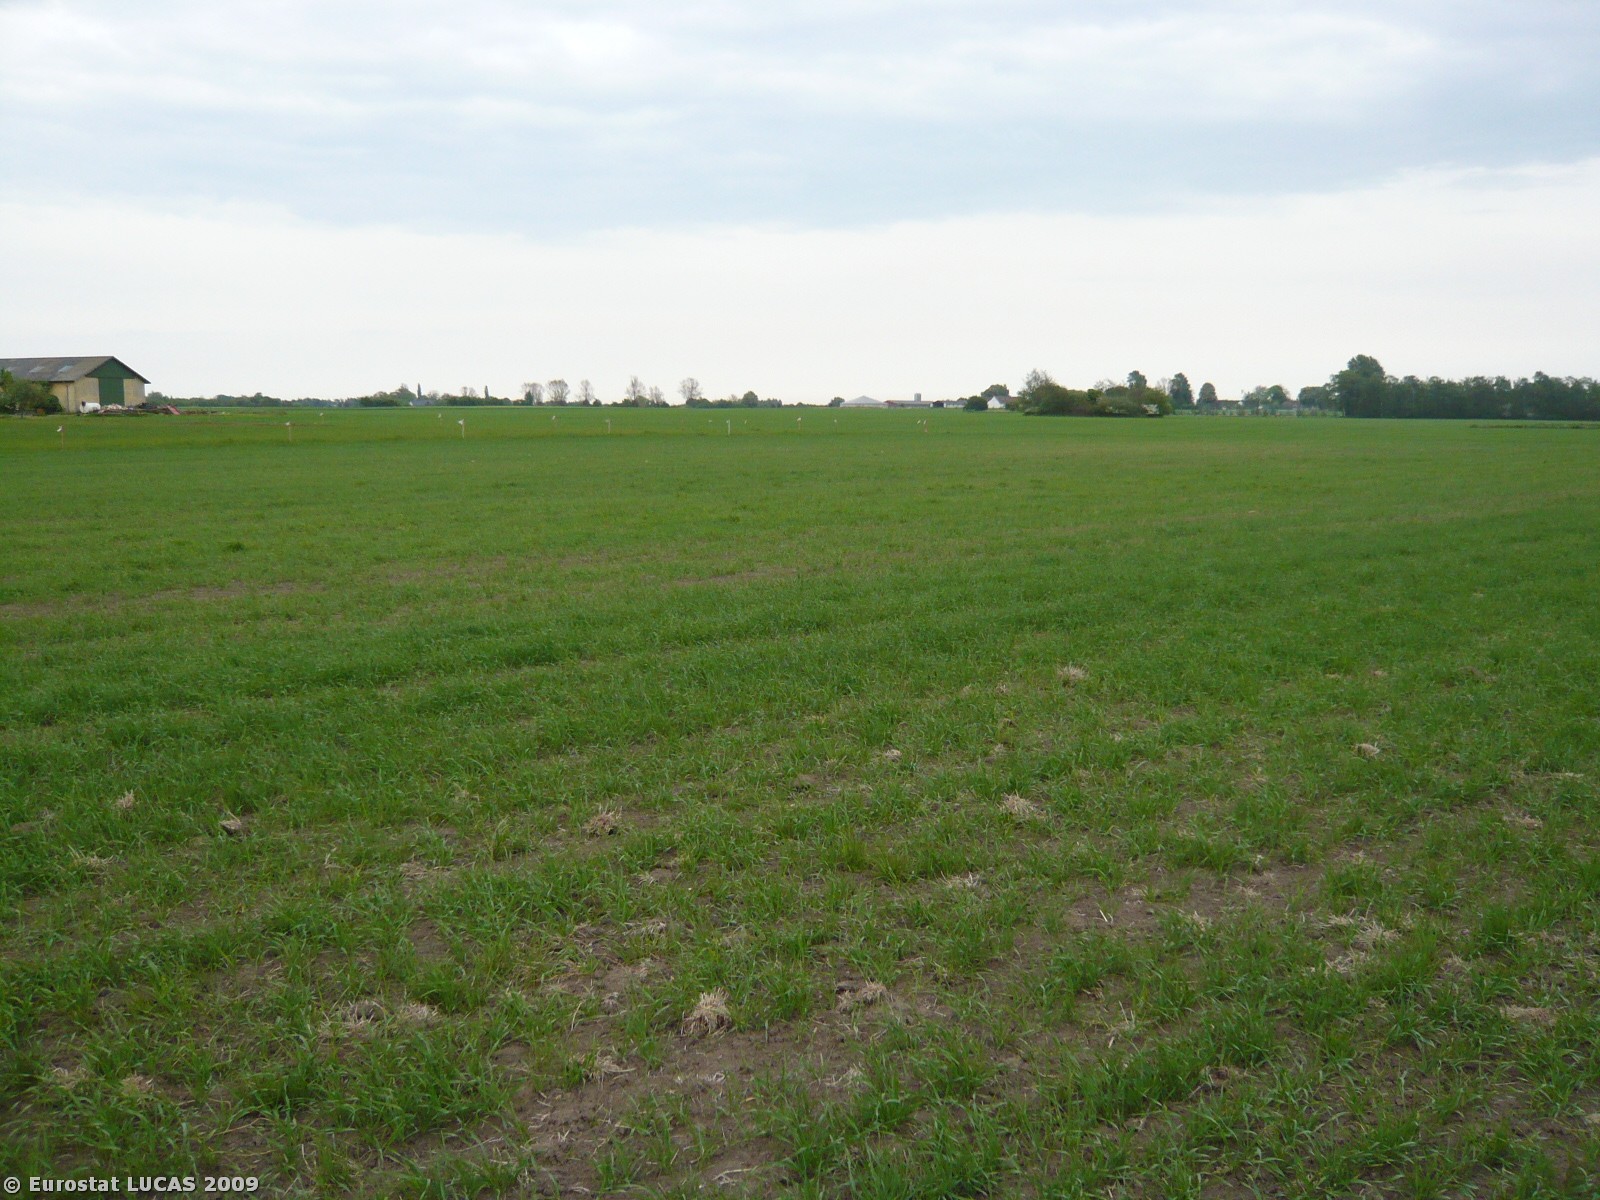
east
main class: Cropland
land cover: Barley
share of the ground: 50 - 75 %
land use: Agriculture (excluding fallow land and kitchen gardens)
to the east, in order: Barley; Fences; Grassland without tree/shrub cover; Fences; Barley
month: May
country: DK
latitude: 55.3604
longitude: 12.1595
